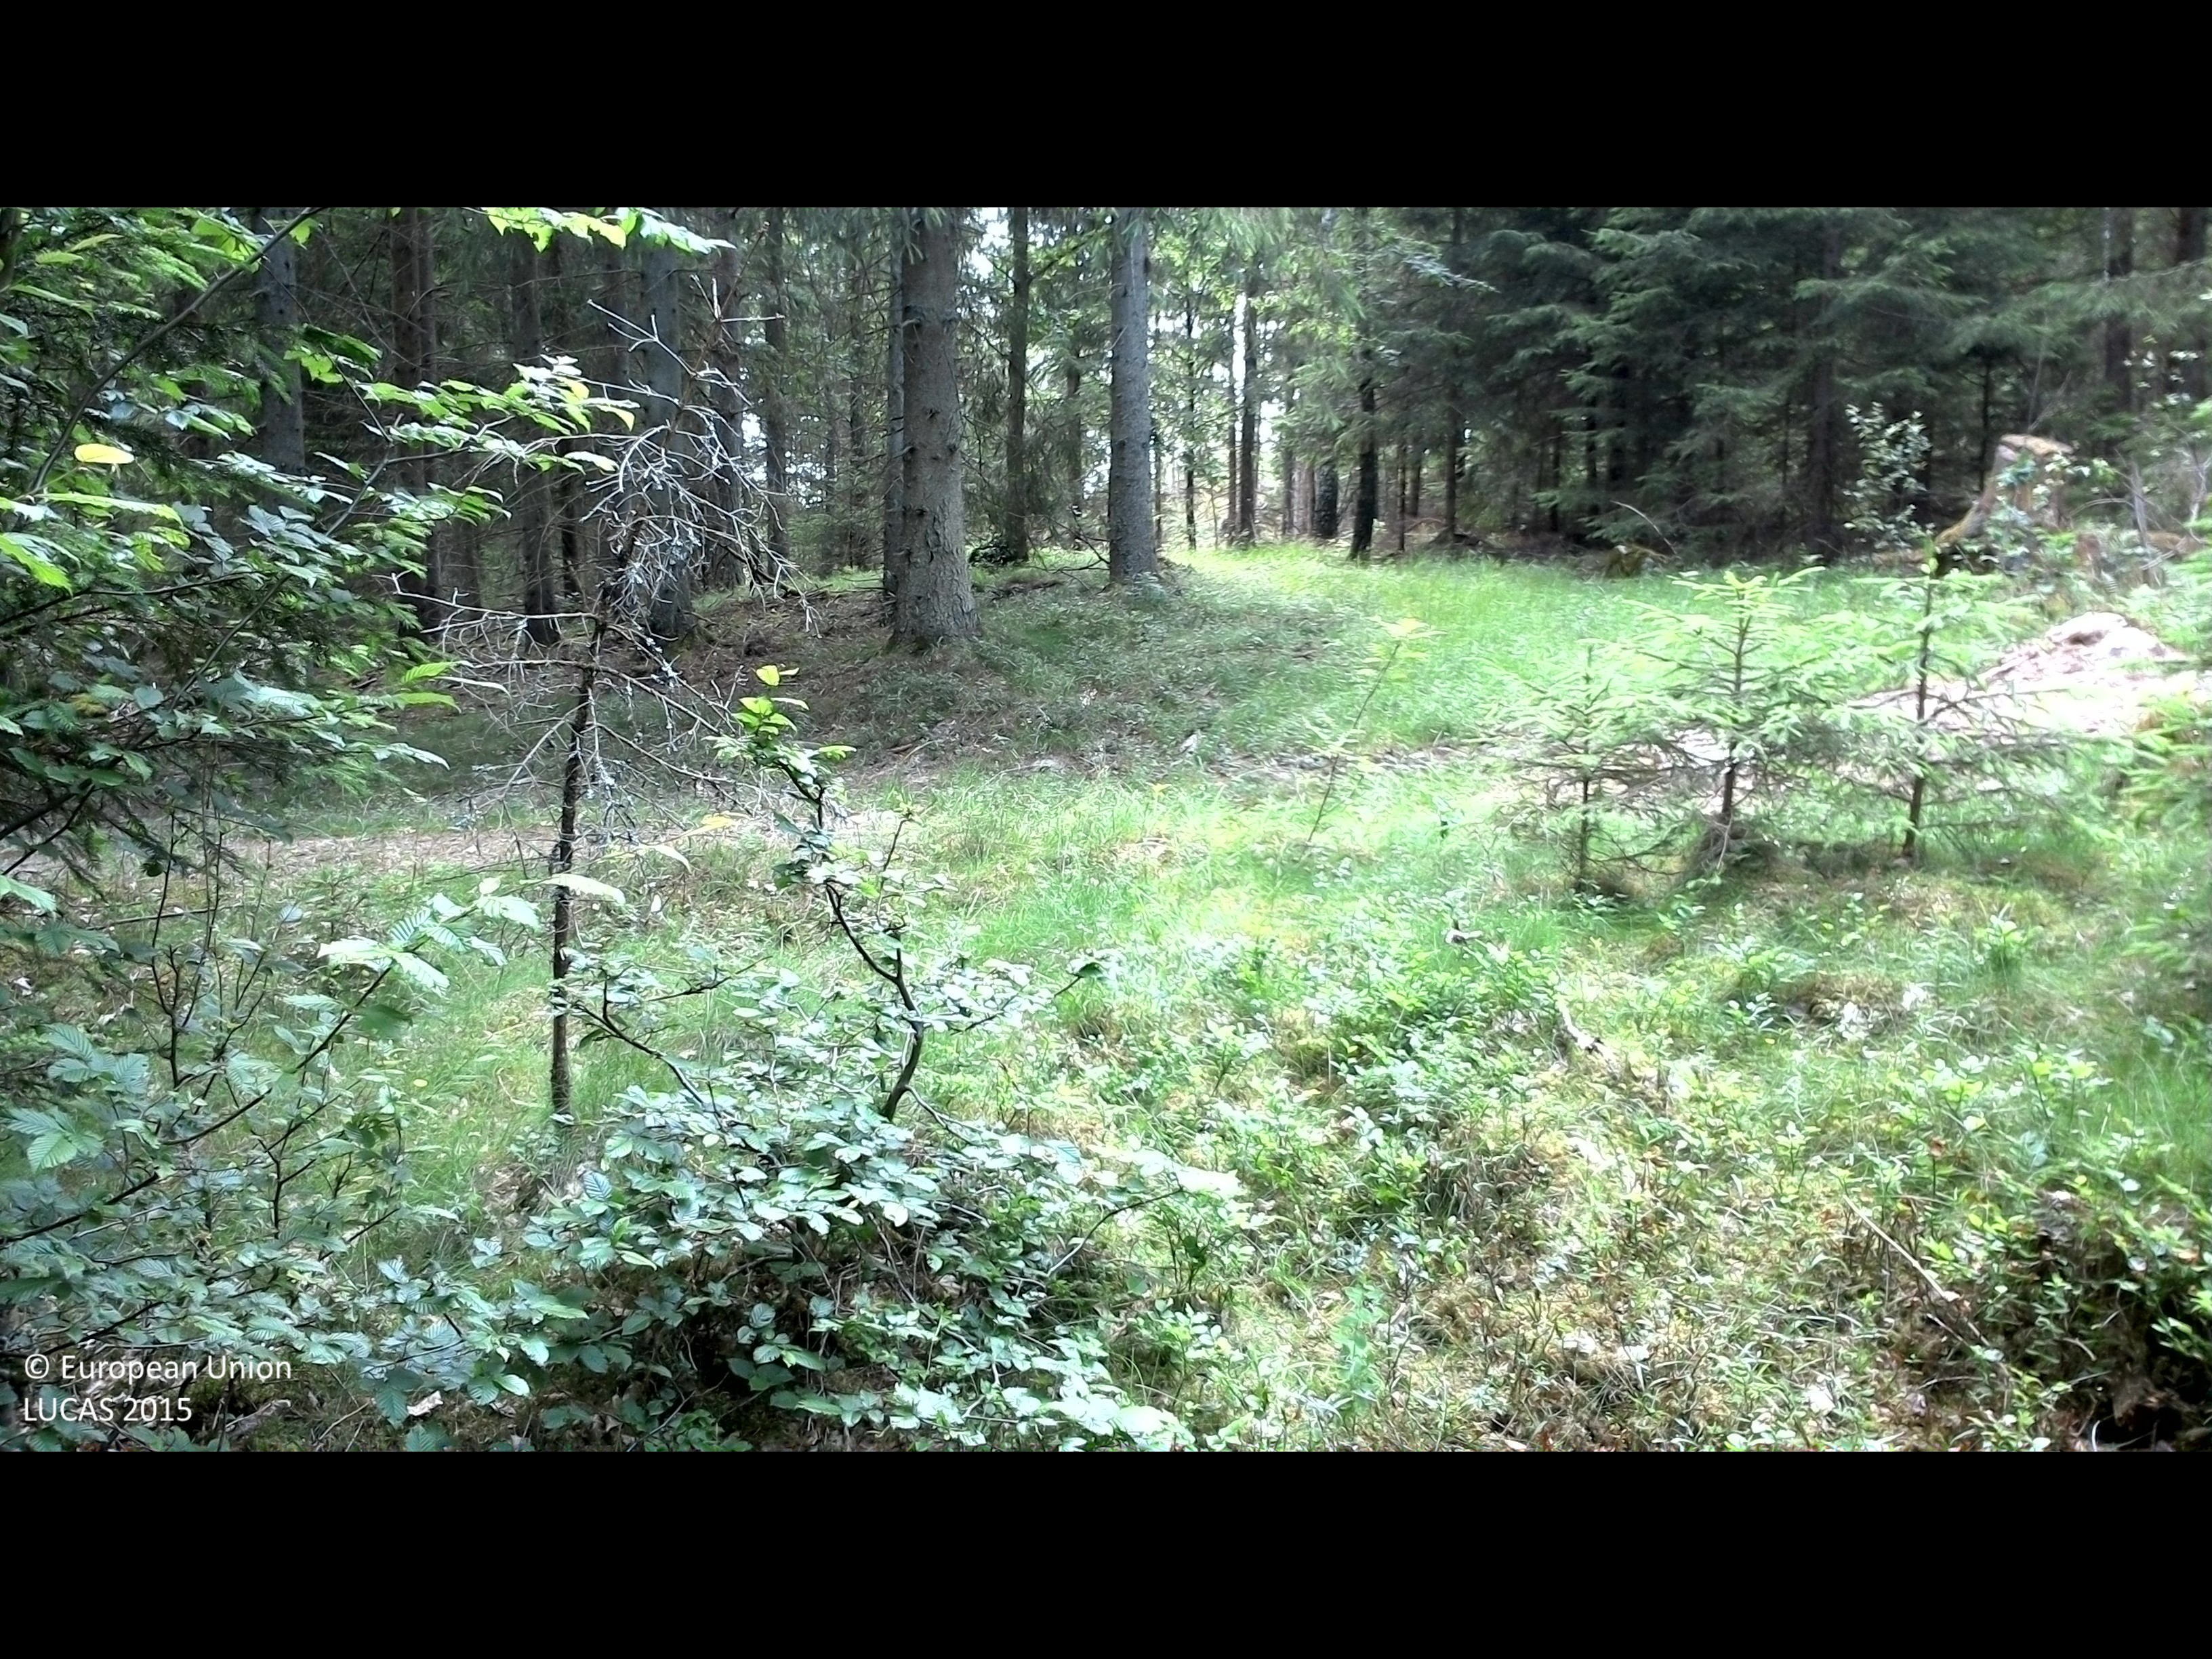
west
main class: Woodland
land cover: Spruce dominated coniferous woodland
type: boreal forest
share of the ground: 50 - 75 %
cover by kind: coniferous forest trees 50 %, shrubs 20 %, herbaceous plants 15 %, lichens and mosses 10 %, broadleaved forest trees 5 %
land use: Forestry
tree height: > 5 m
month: July
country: SE
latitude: 56.3311
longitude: 15.2876
